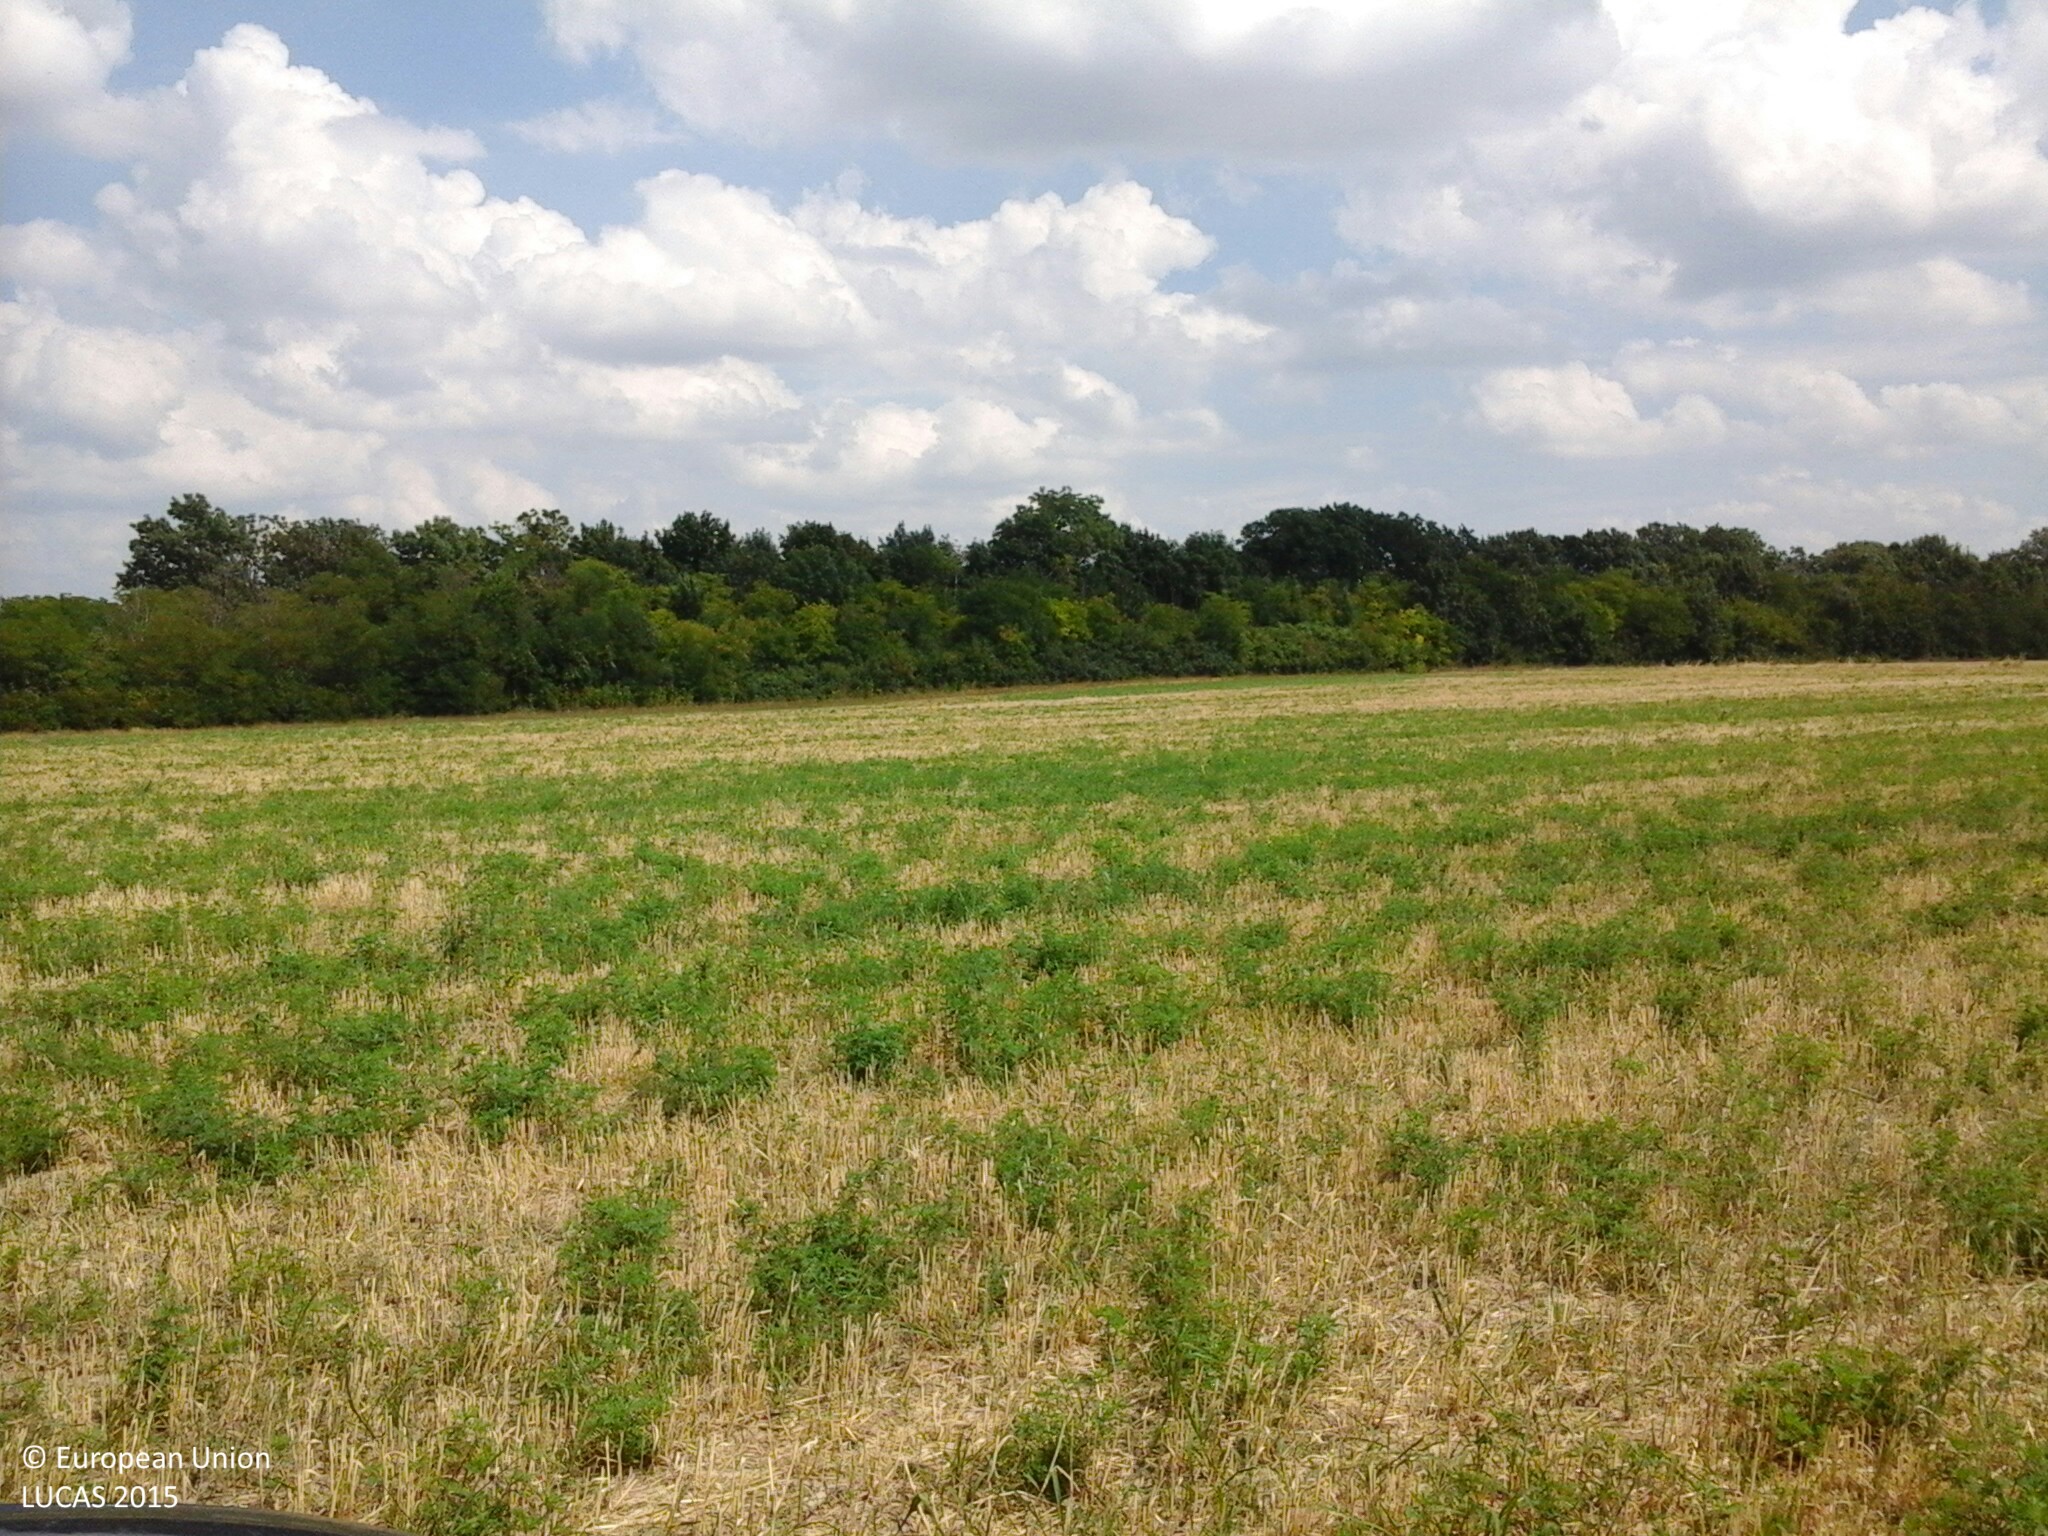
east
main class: Cropland
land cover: Maize
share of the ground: > 75 %
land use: Agriculture (excluding fallow land and kitchen gardens)
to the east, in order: Maize; Common wheat; Tracks; Broadleaved woodland; Rape and turnip rape
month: August
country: HU
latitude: 47.0545
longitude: 18.1326
